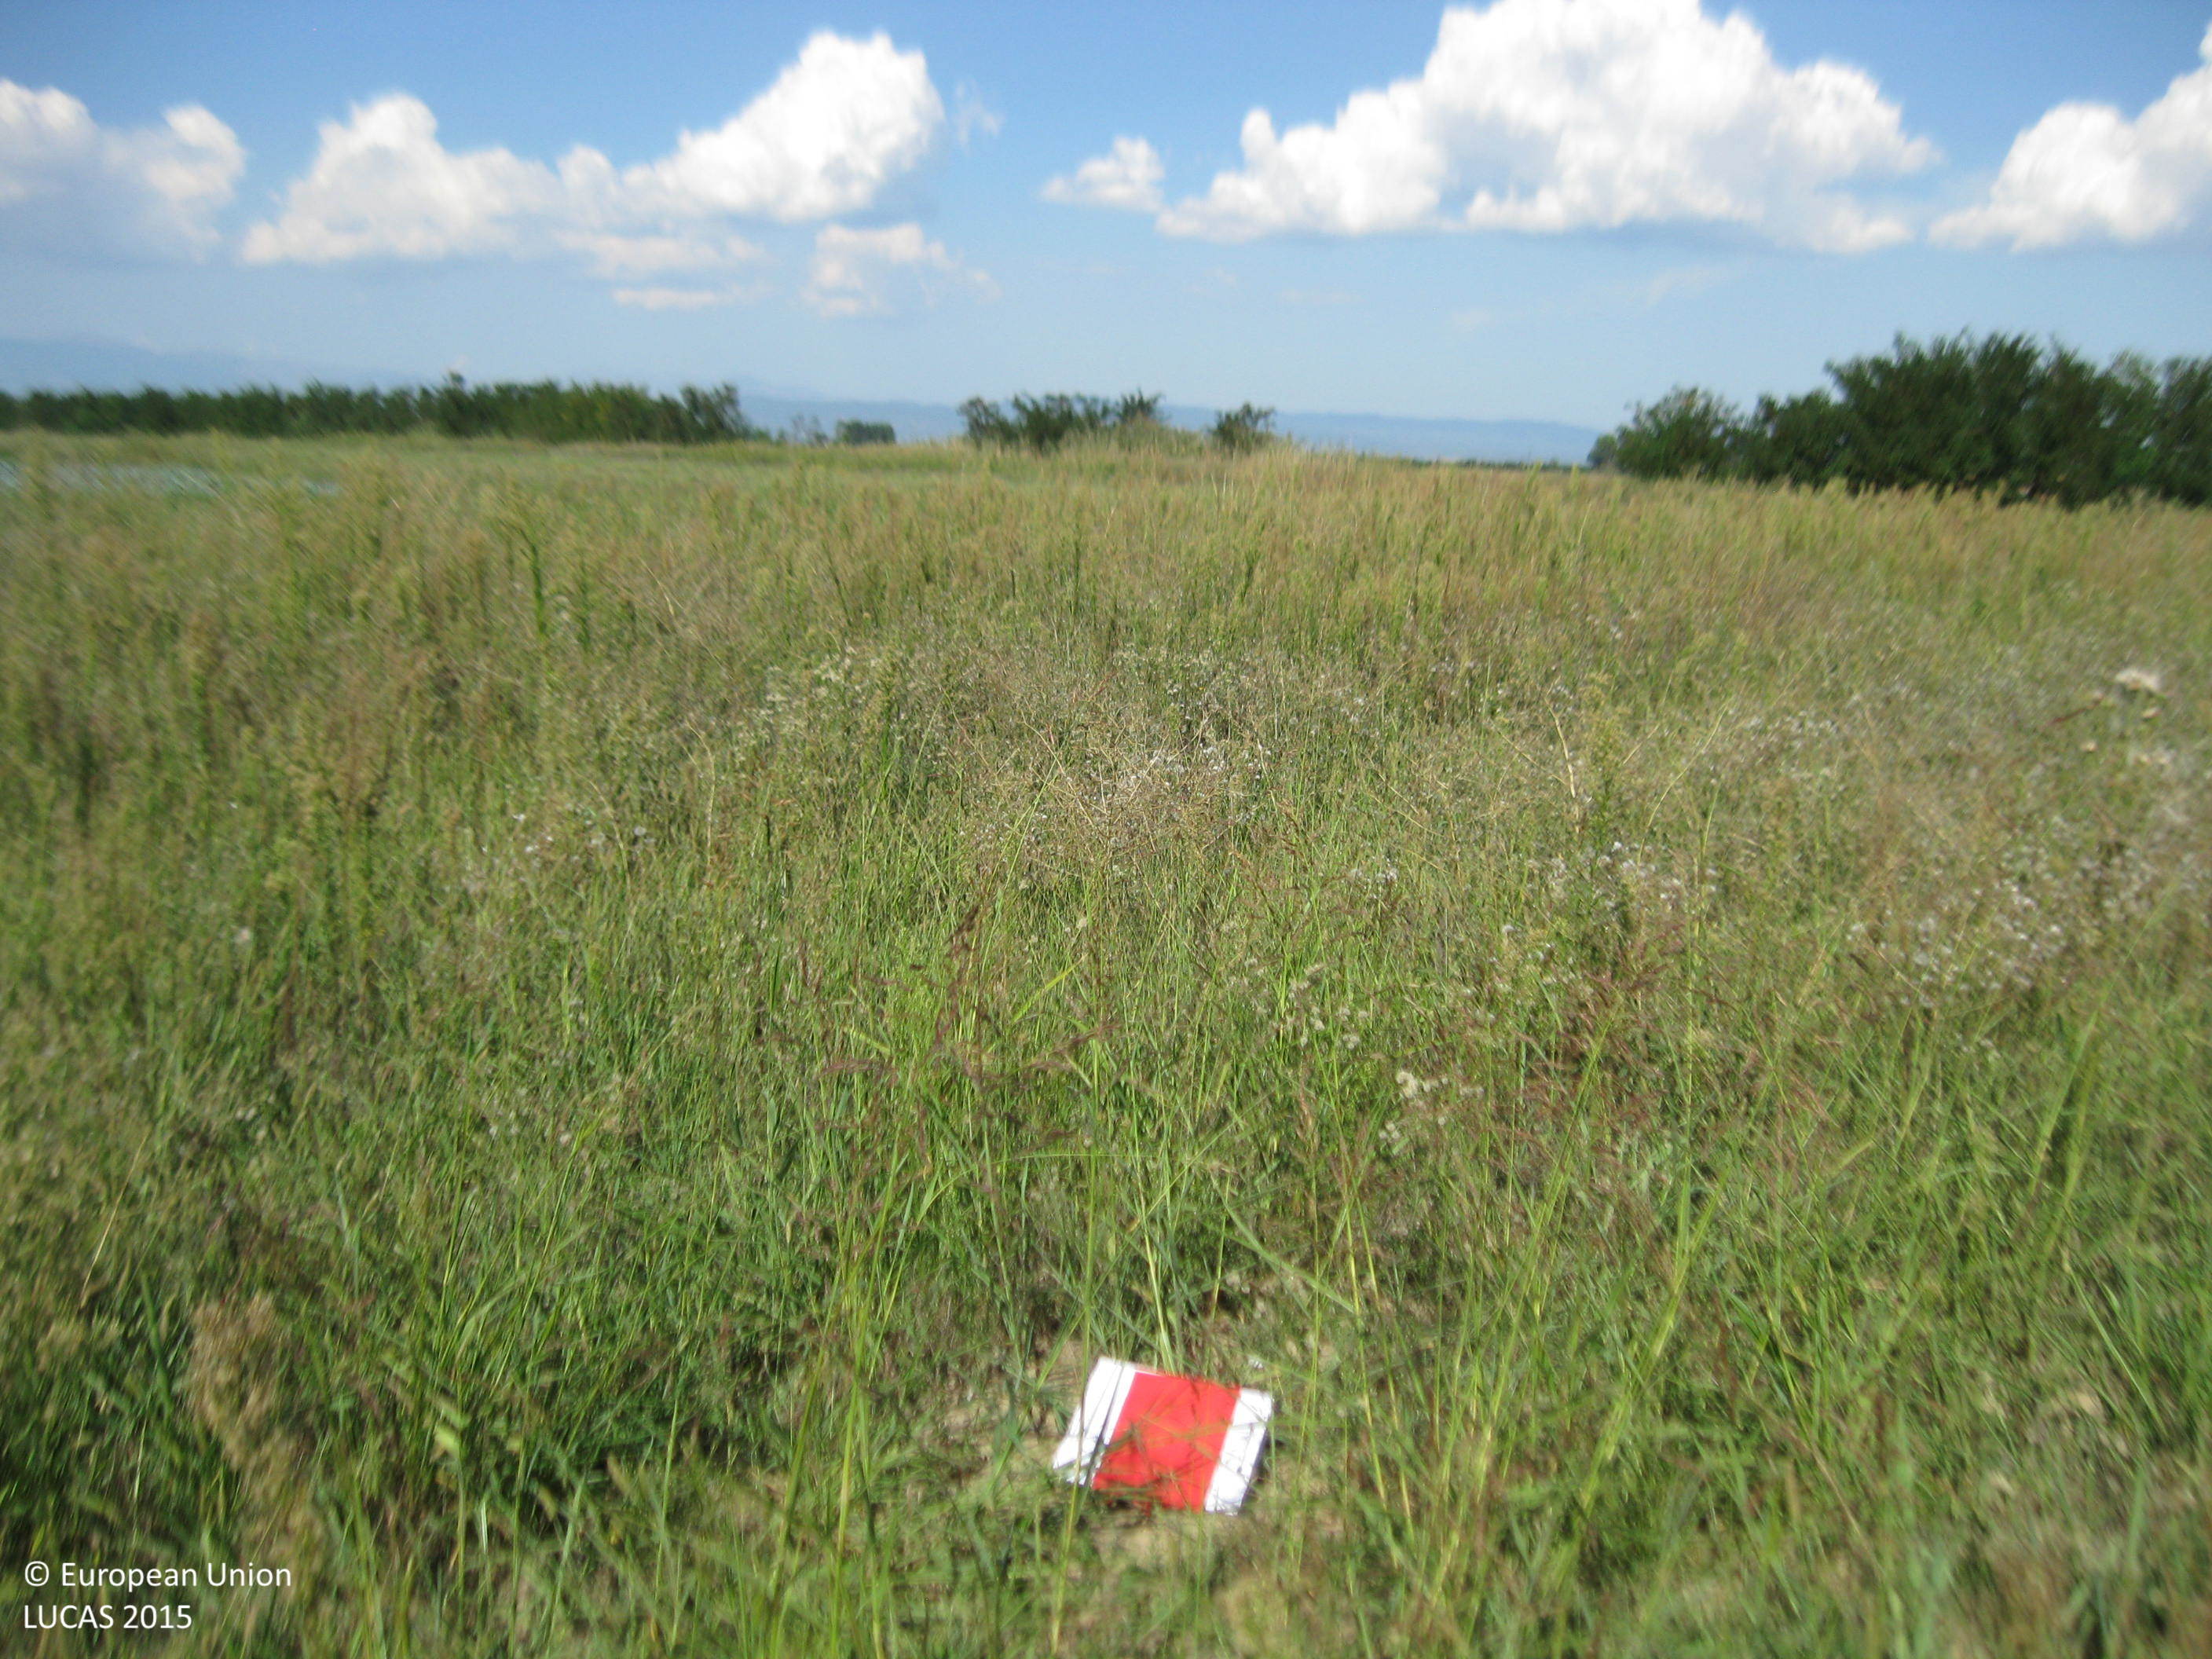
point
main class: Grassland
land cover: Spontaneously vegetated surfaces
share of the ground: > 75 %
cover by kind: herbaceous plants 100 %
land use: Fallow land
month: September
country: BG
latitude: 42.2944
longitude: 24.7905
